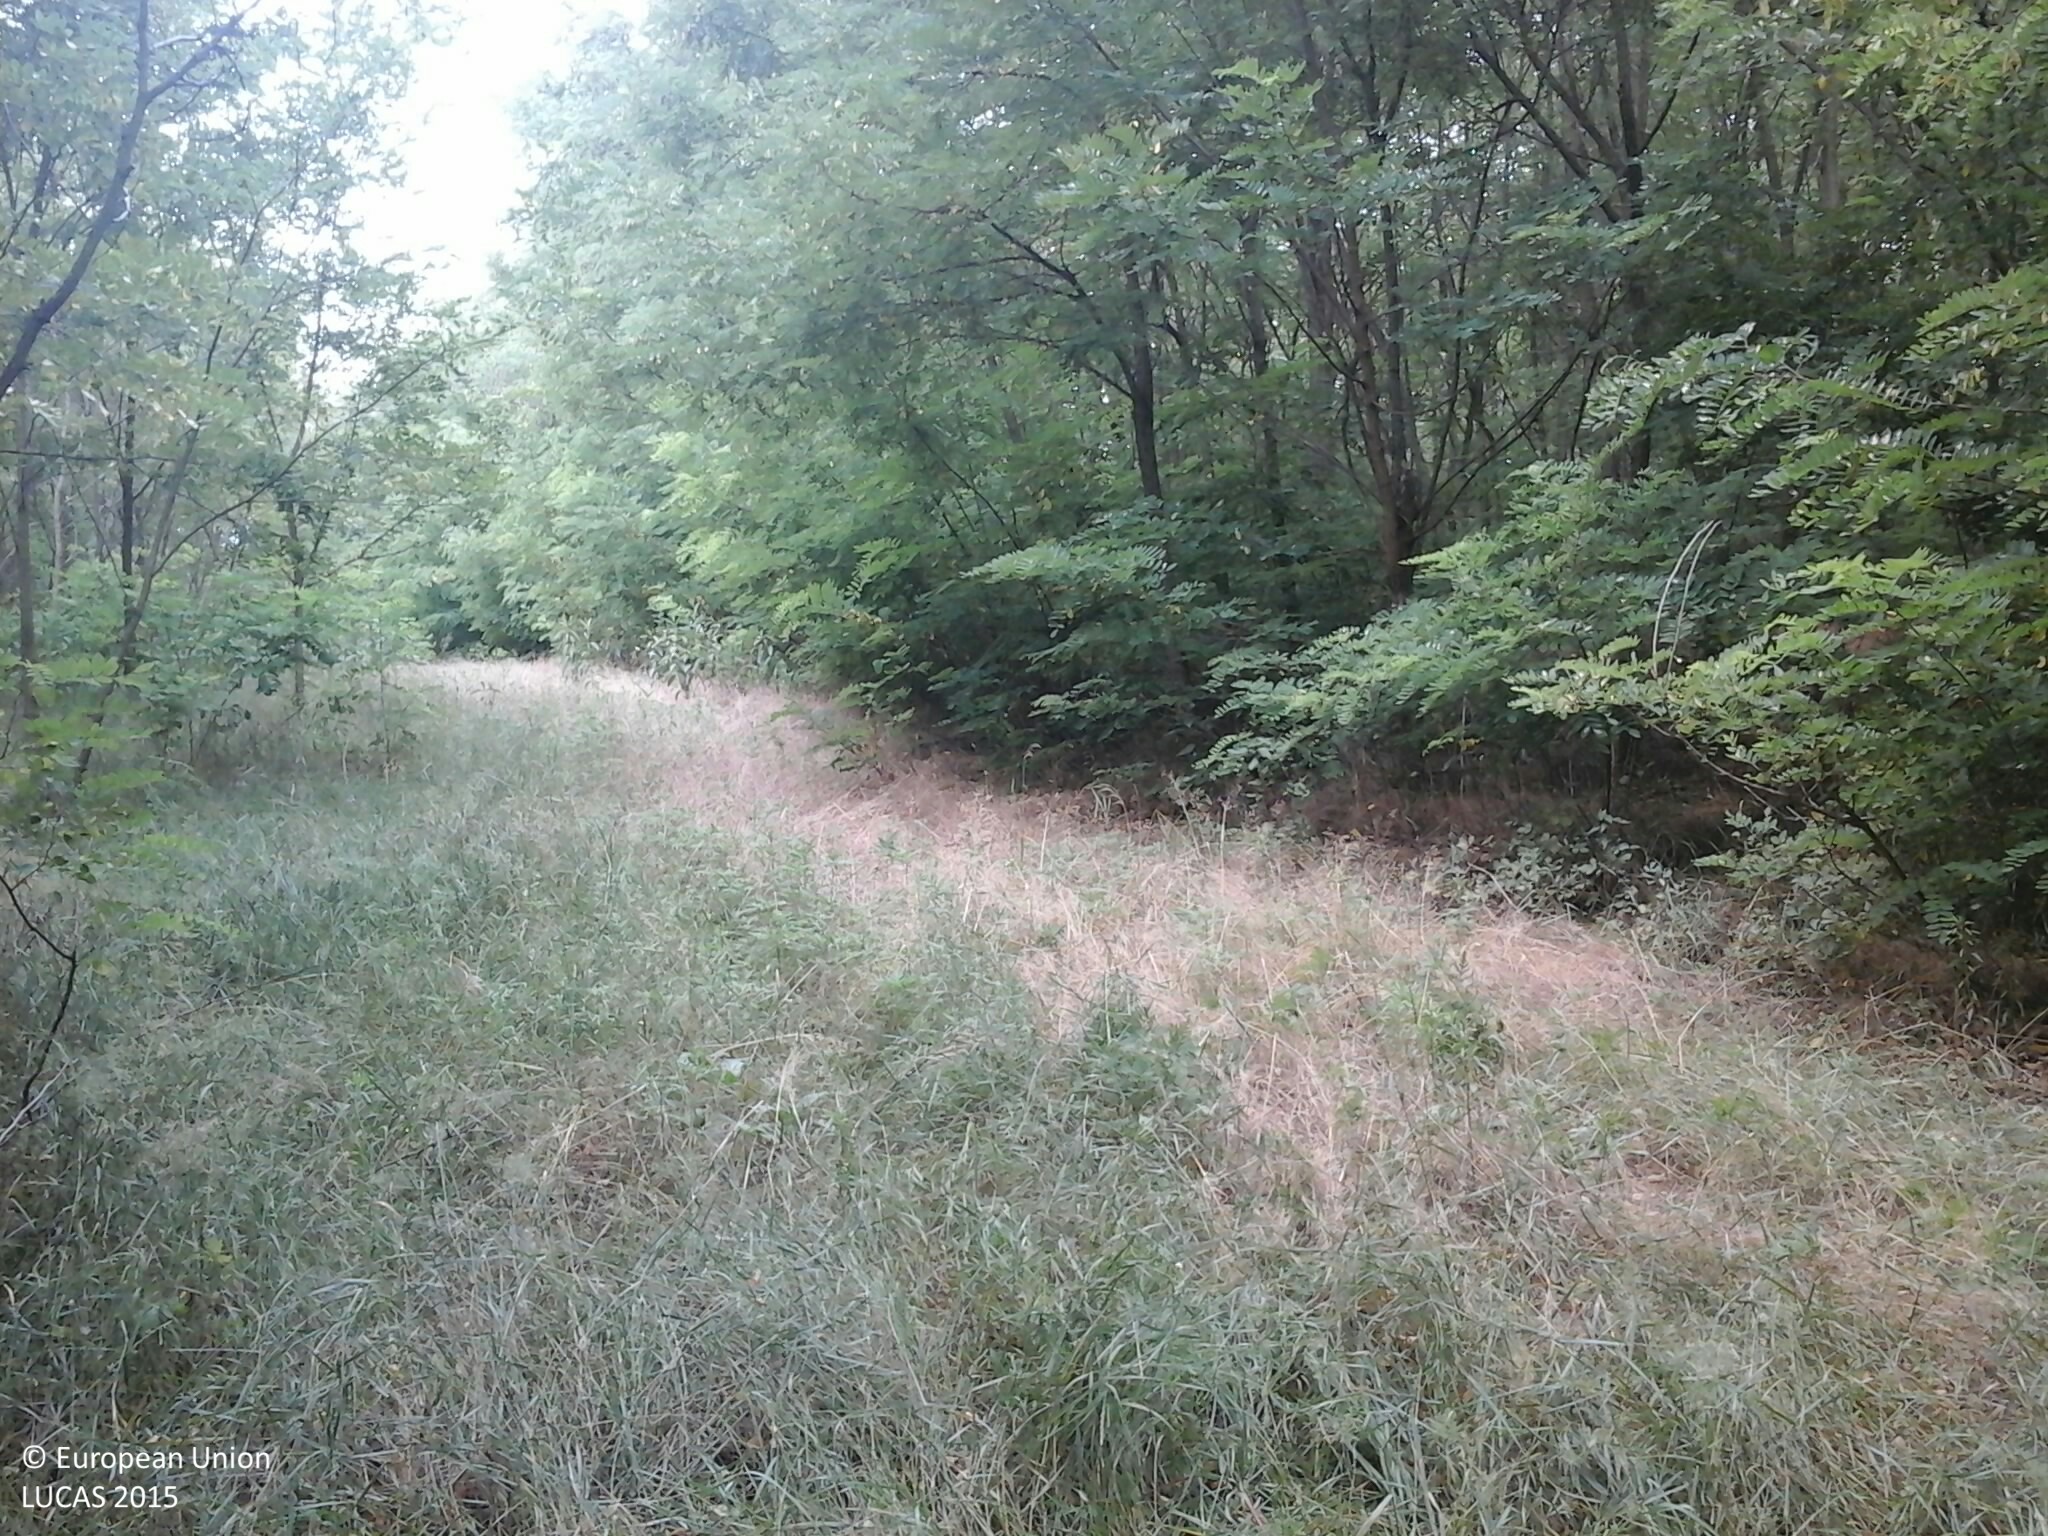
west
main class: Woodland
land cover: Broadleaved woodland
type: mesophytic deciduous forest
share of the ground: > 75 %
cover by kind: broadleaved forest trees 95 %, herbaceous plants 5 %
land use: Forestry
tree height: > 5 m
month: July
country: HU
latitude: 47.8284
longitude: 22.0885
